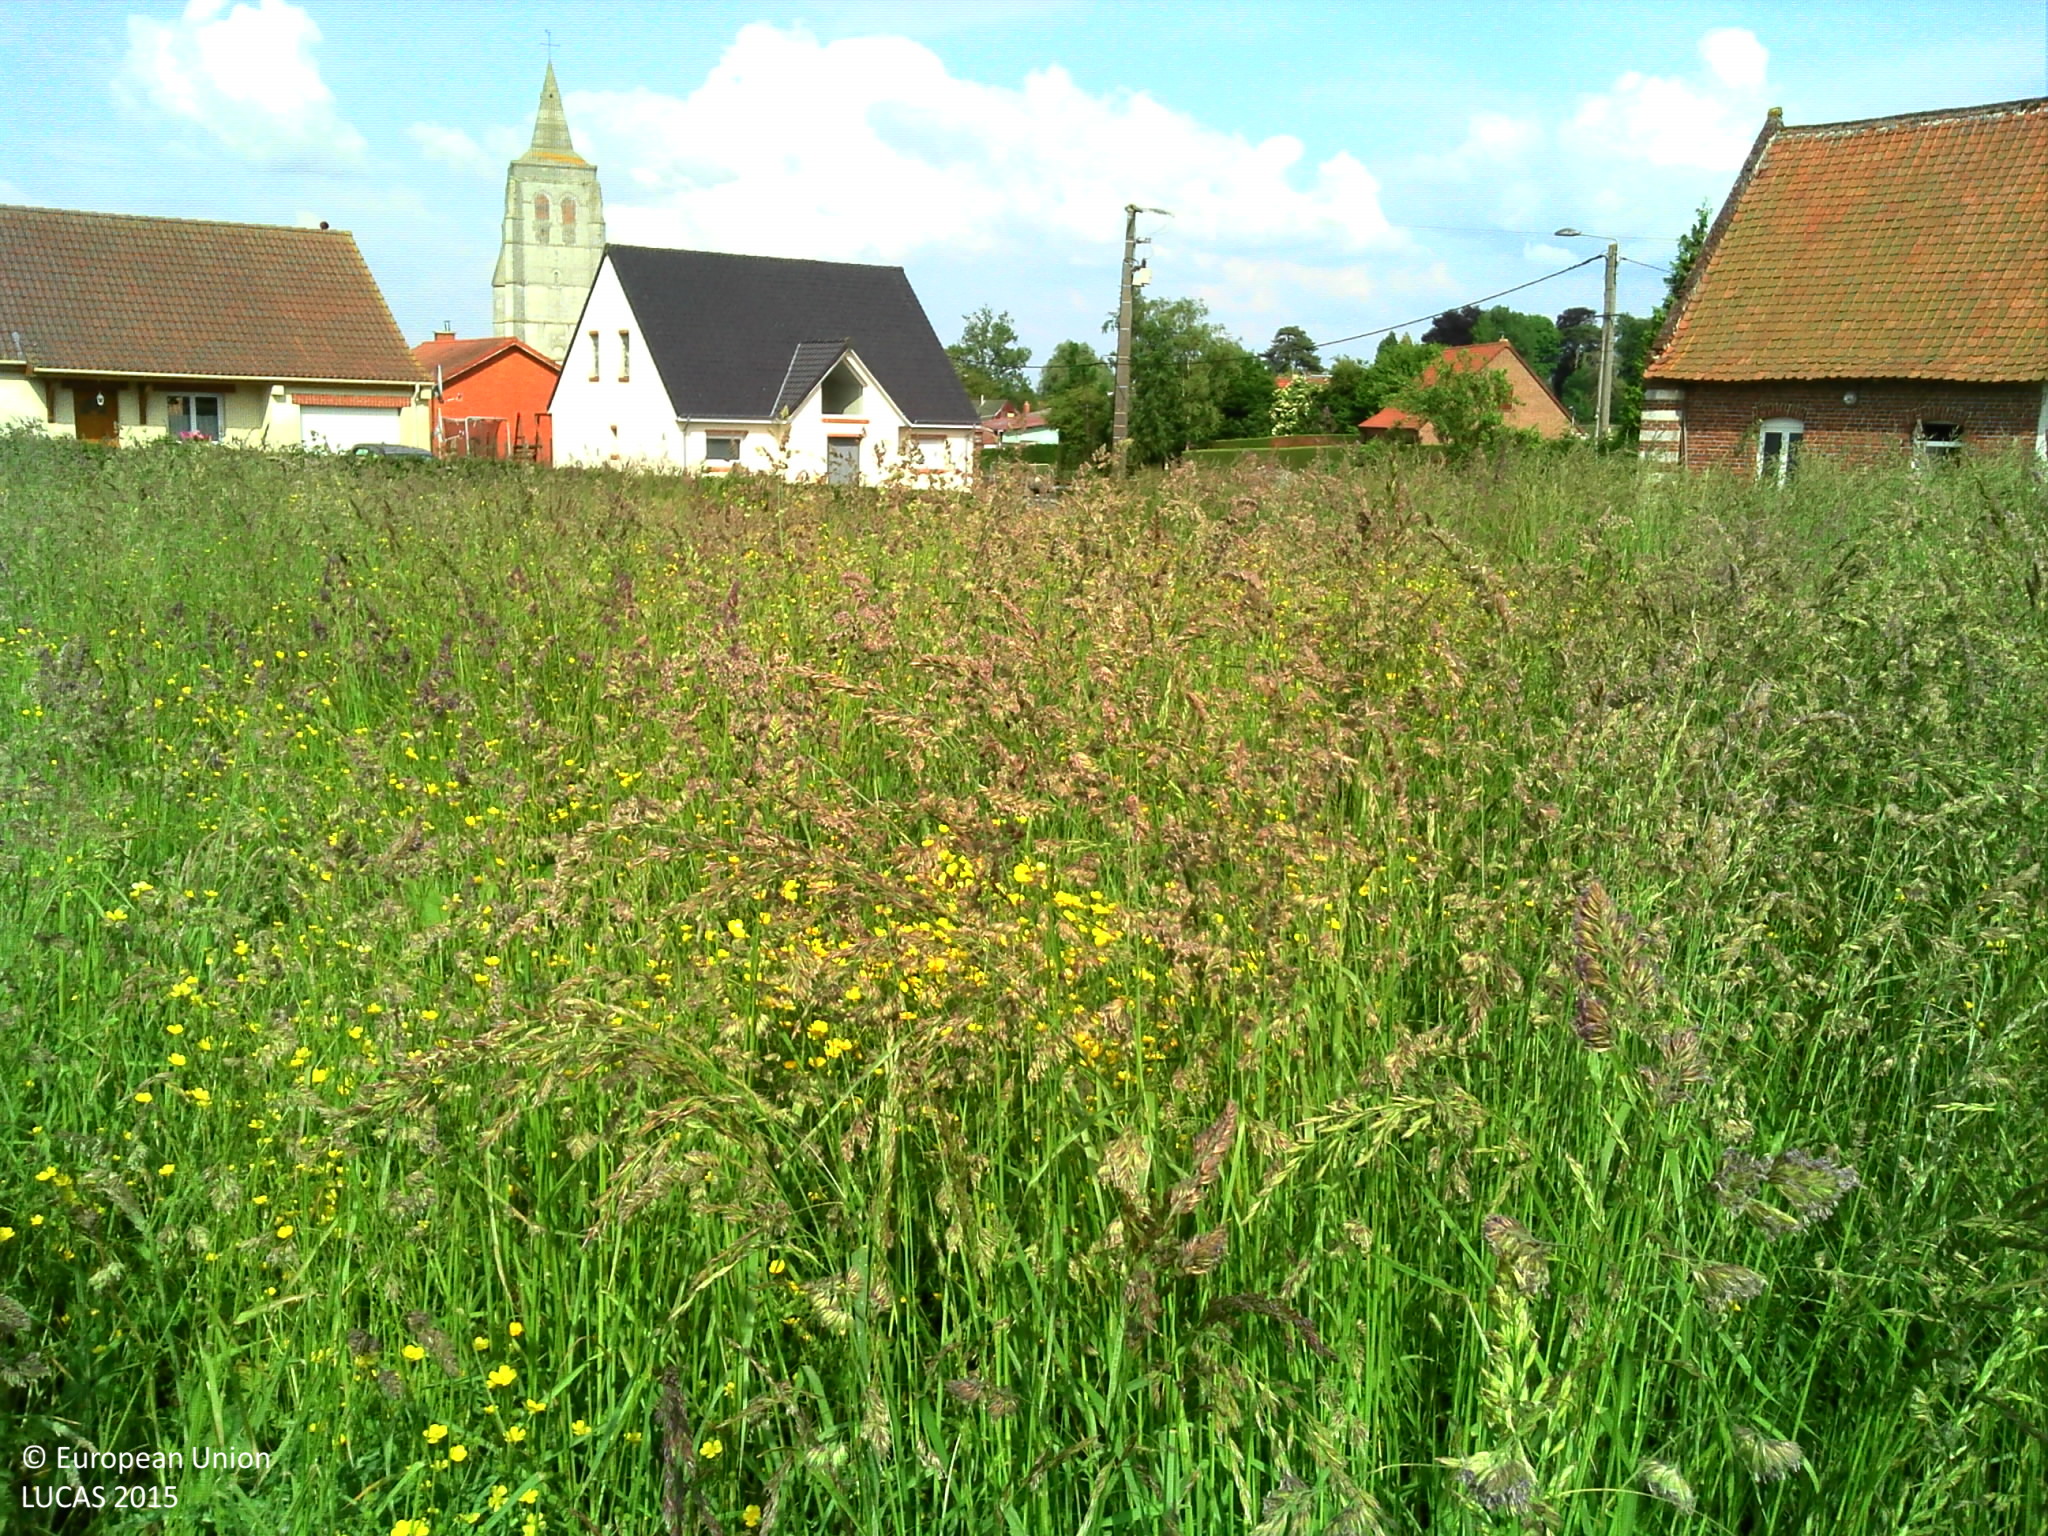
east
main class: Grassland
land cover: Grassland without tree/shrub cover
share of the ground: > 75 %
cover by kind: herbaceous plants 90 %
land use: Agriculture (excluding fallow land and kitchen gardens)
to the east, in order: Grassland without tree/shrub cover; Artificial constructions in urban areas; Grassland without tree/shrub cover; Artificial constructions in urban areas; Spontaneously vegetated surfaces; Fences; Grassland without tree/shrub cover; Artificial constructions in urban areas
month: June
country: FR
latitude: 50.4341
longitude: 2.3700
